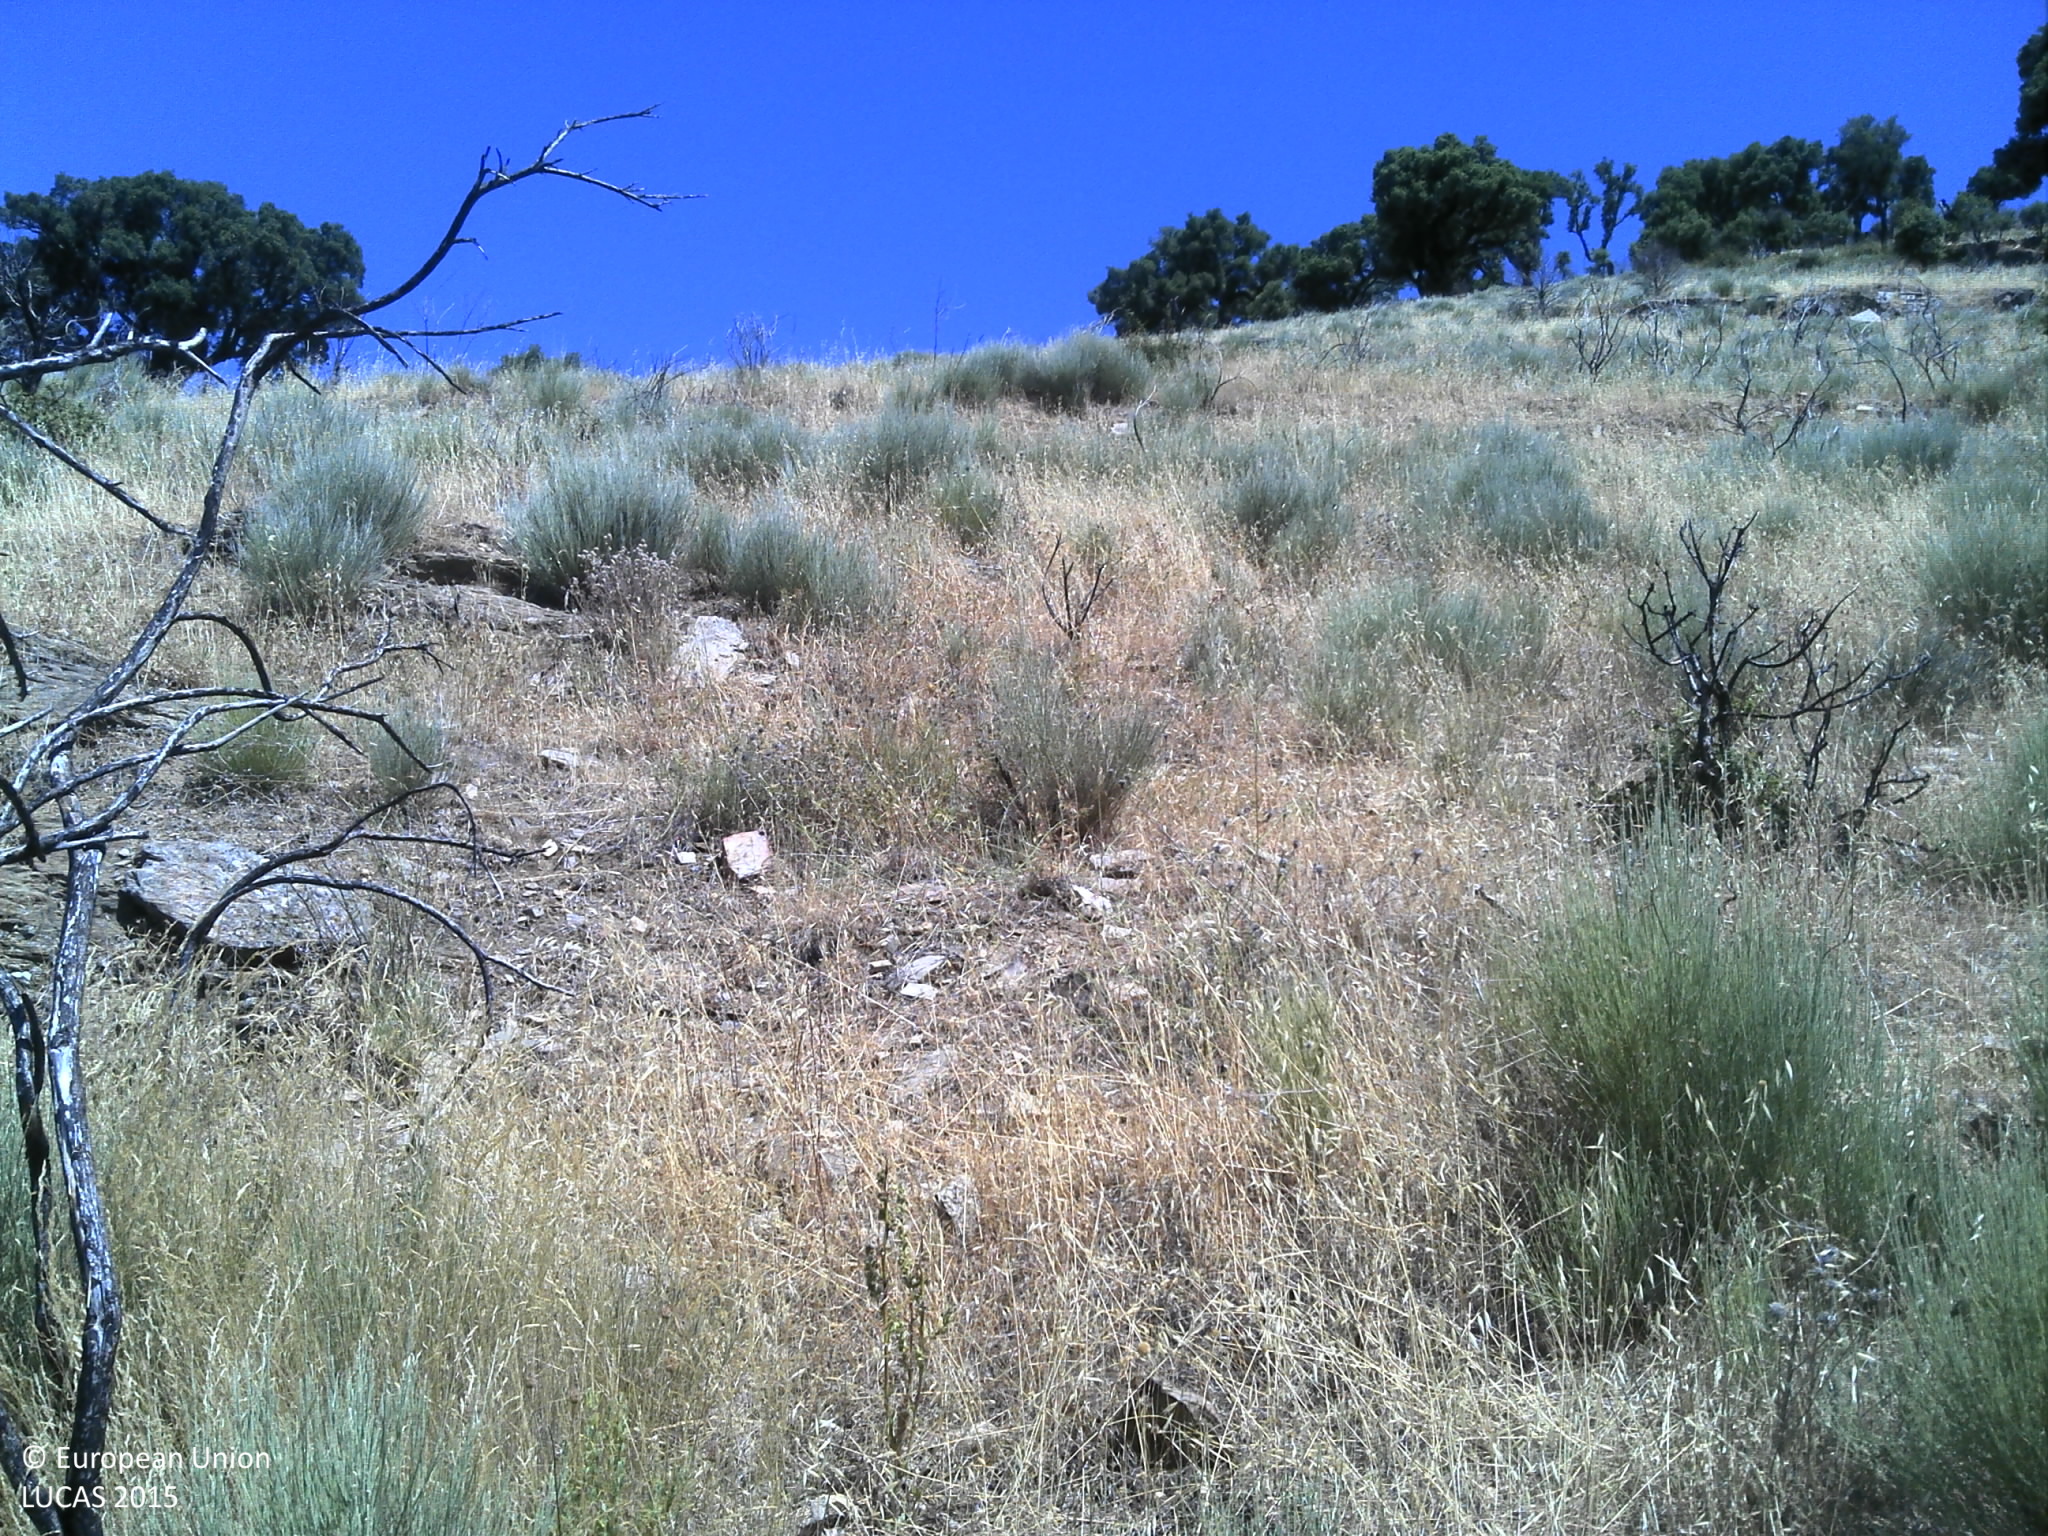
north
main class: Shrubland
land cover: Shrubland without tree cover
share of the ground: > 75 %
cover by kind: shrubs 75 %, unconsolidated bare surface 15 %, herbaceous plants 10 %
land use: Abandoned areas
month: July
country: PT
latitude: 41.4219
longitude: -7.0206
